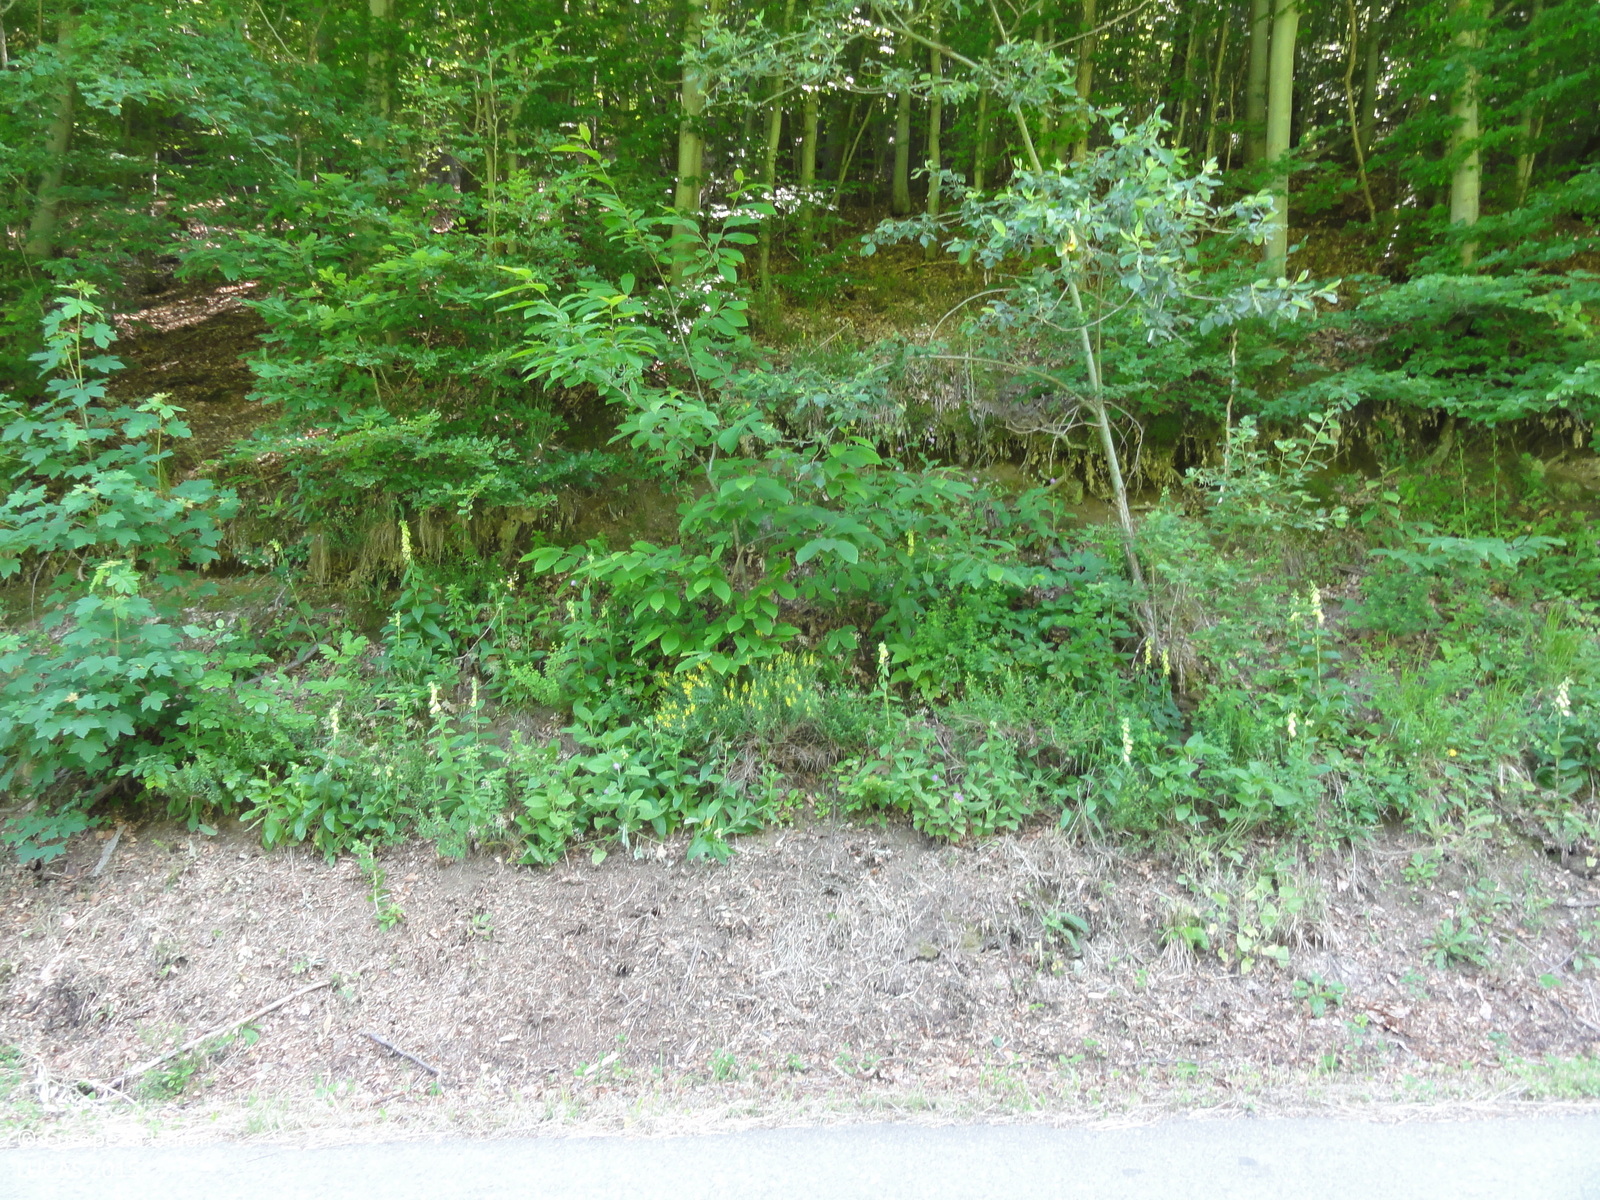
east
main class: Grassland
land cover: Spontaneously vegetated surfaces
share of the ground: > 75 %
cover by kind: herbaceous plants 95 %, shrubs 5 %
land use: Semi-natural and natural areas not in use
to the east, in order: Spontaneously vegetated surfaces; Paved roads, cycling and walking lanes; Shruby margins; Broadleaved woodland; Spruce dominated mixed woodland; Broadleaved woodland; Ditches and canals; Broadleaved woodland; Ditches and canals; Broadleaved woodland; Ditches and canals; Broadleaved woodland; Tracks; Broadleaved woodland
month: June
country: SI
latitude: 46.3394
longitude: 15.7803
